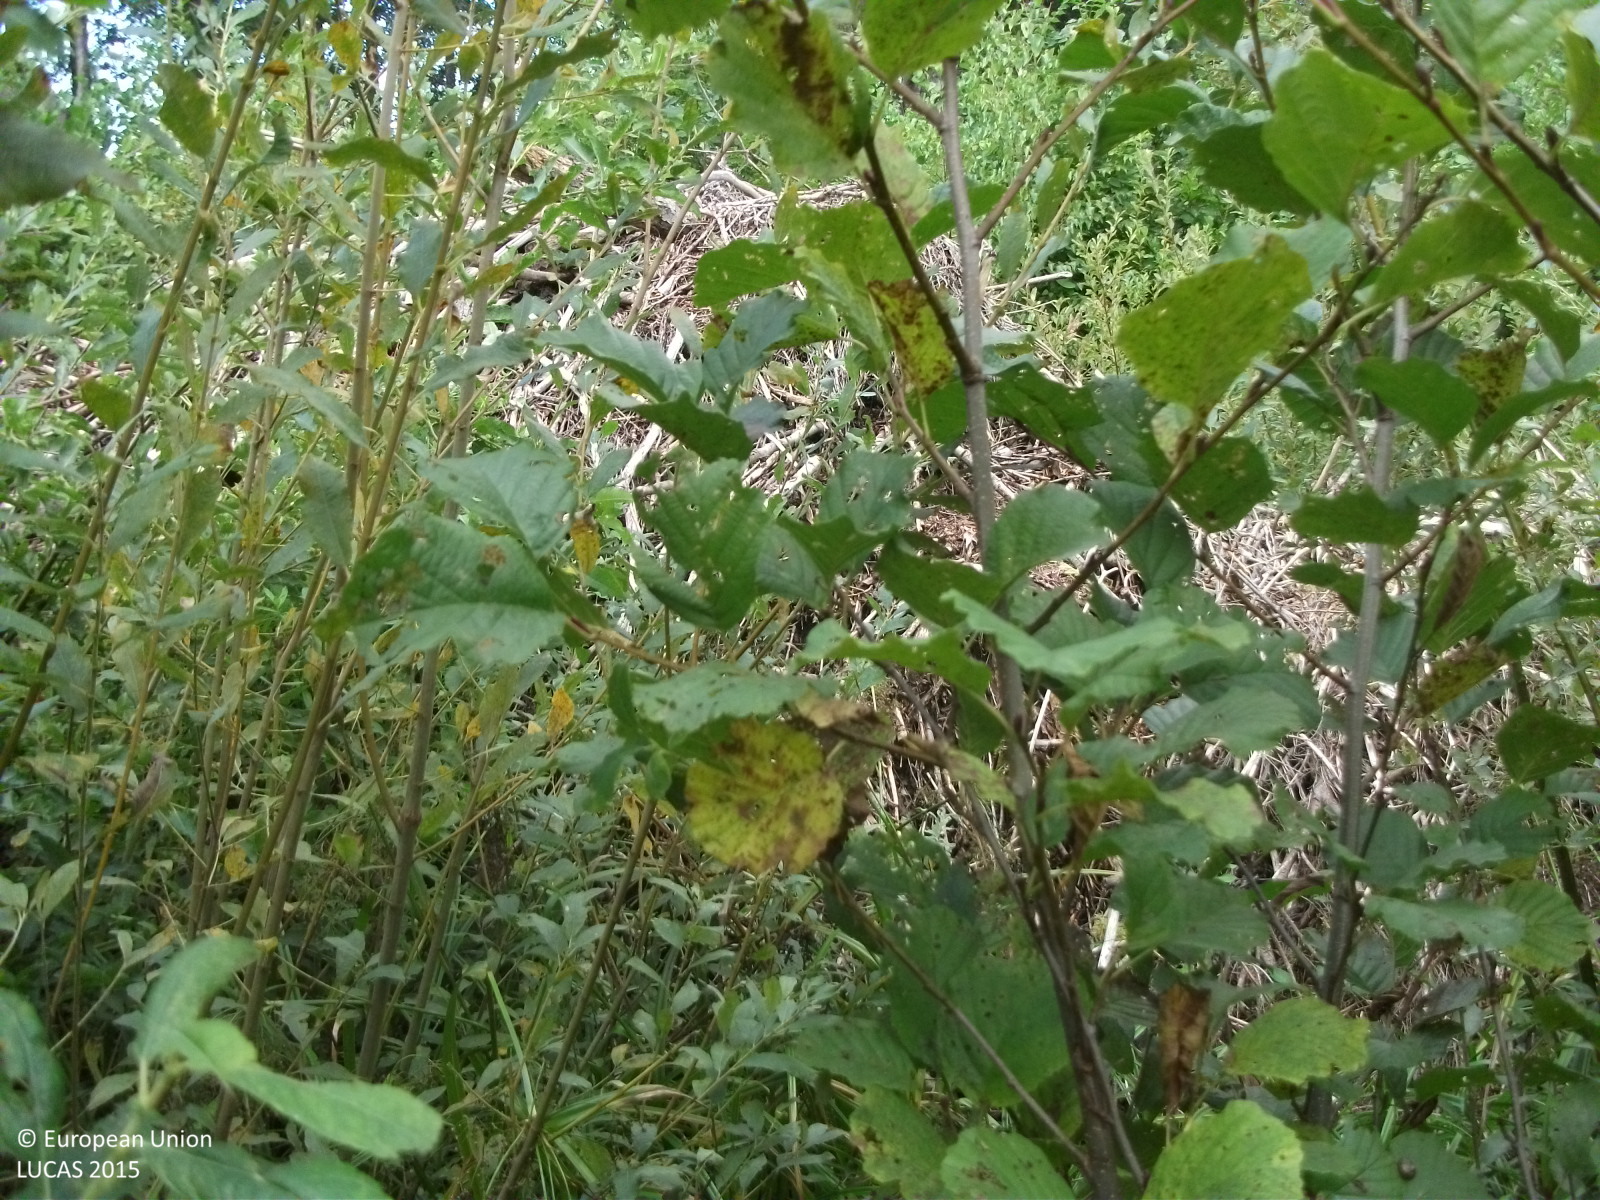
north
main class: Shrubland
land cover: Shrubland with sparse tree cover
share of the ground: > 75 %
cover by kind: shrubs 80 %, herbaceous plants 15 %, broadleaved forest trees 5 %
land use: Semi-natural and natural areas not in use
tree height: < 5 m
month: September
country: LV
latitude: 57.4945
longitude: 24.3874
